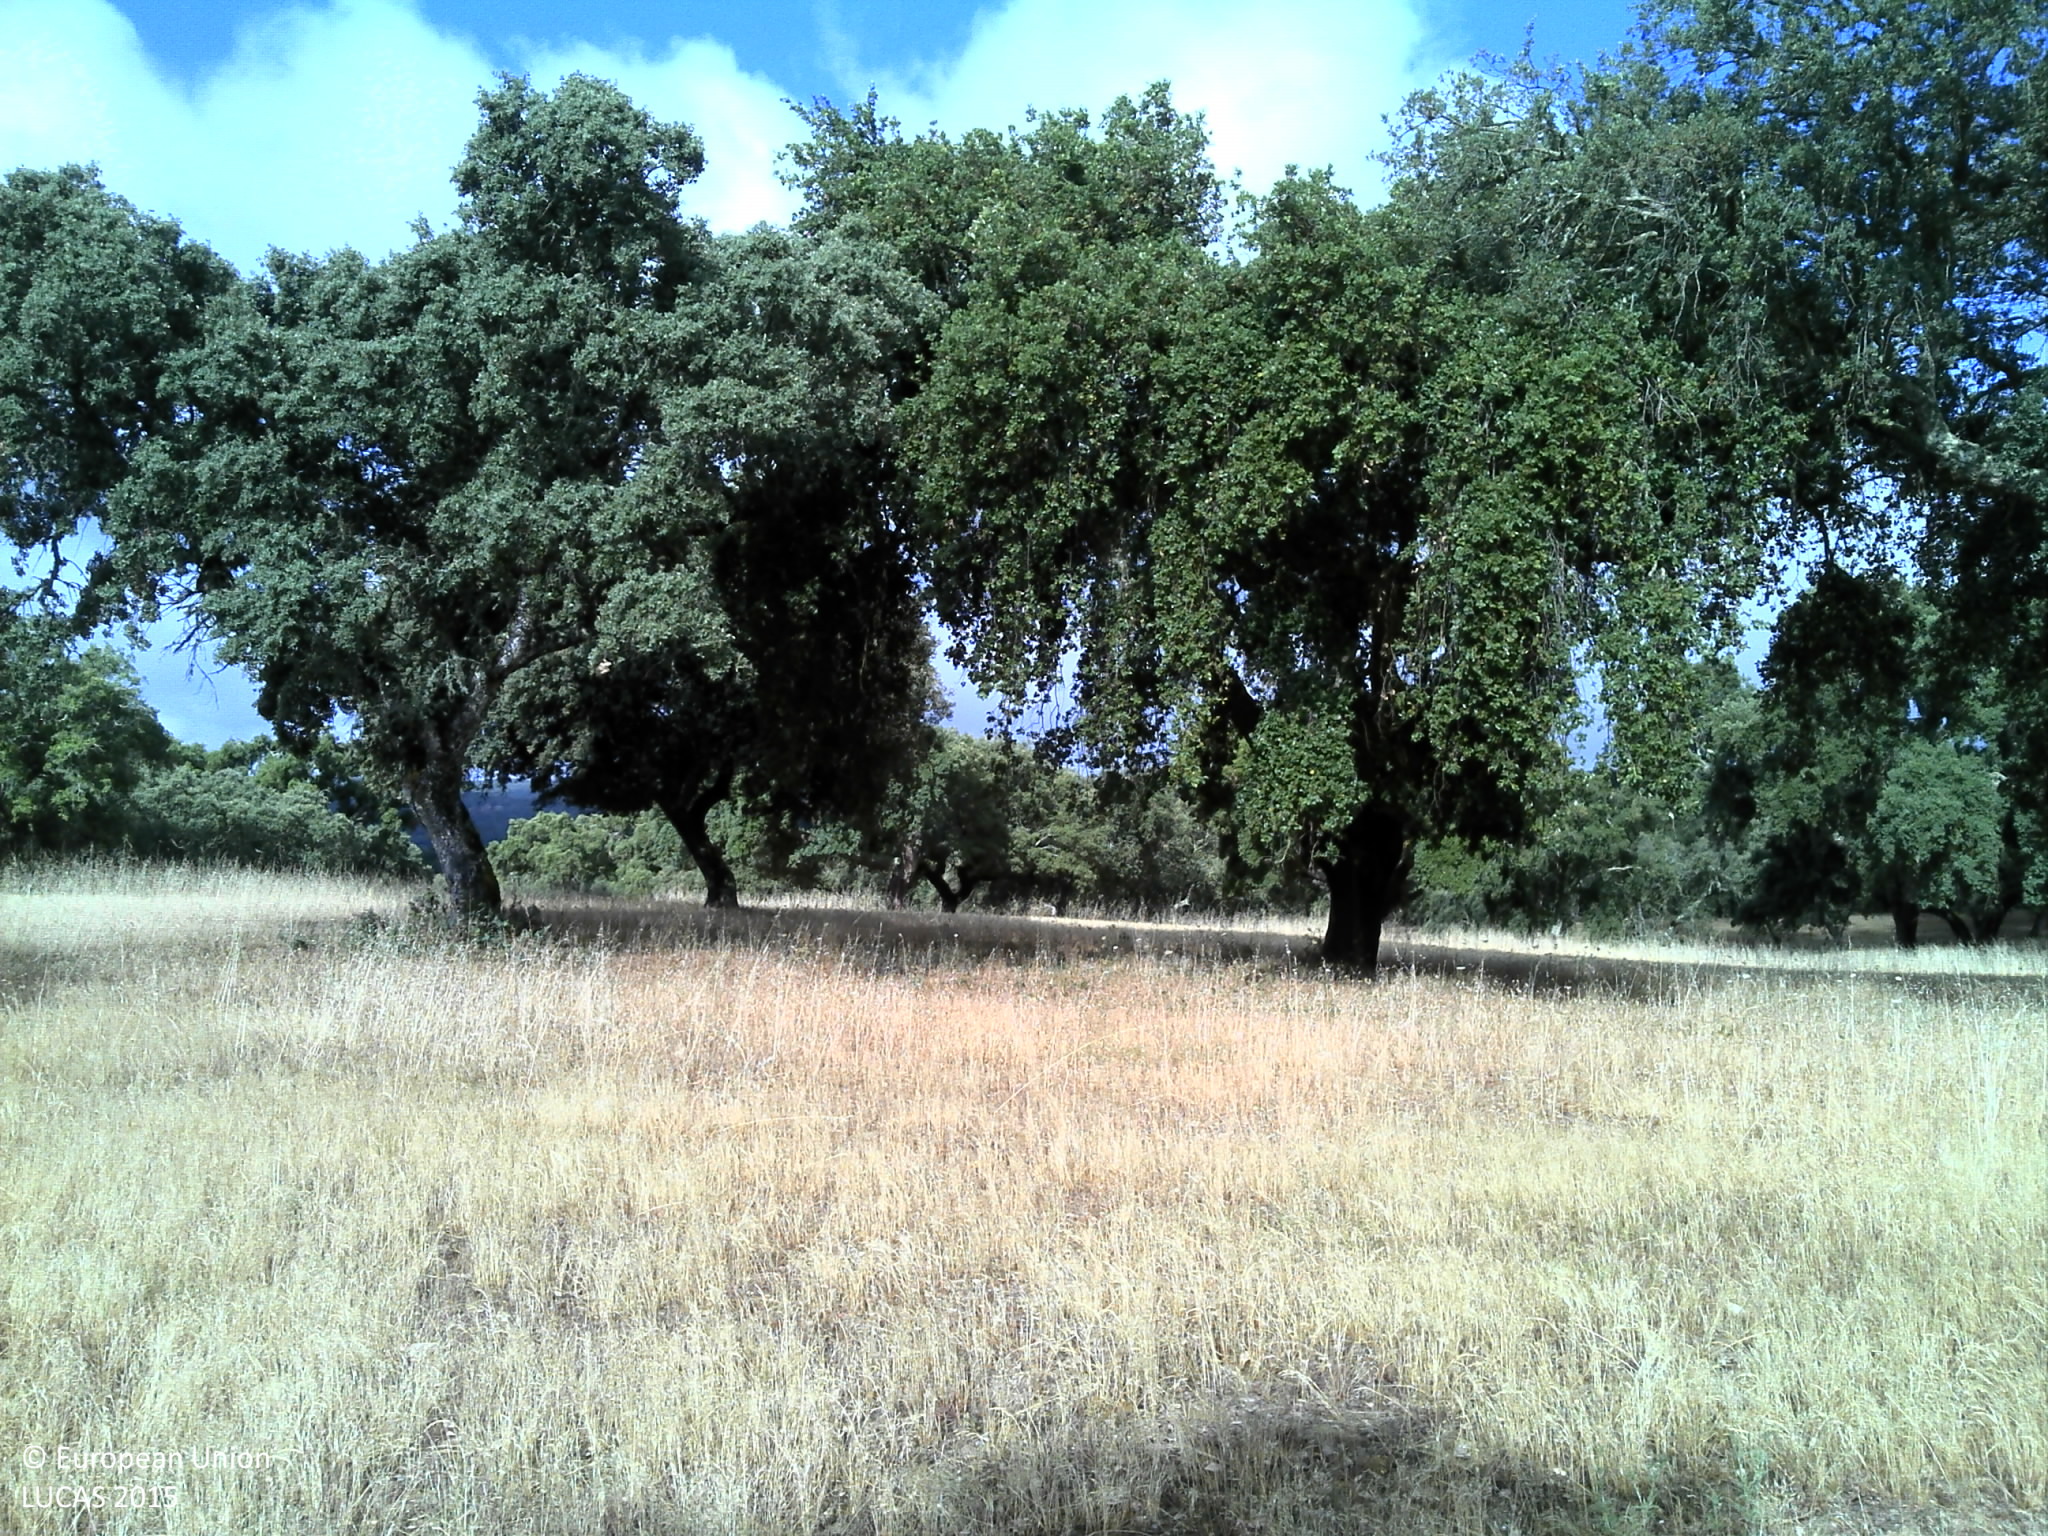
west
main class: Woodland
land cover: Broadleaved woodland
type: broadleaved evergreen forest
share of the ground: 10 - 25 %
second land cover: Spontaneously vegetated surfaces
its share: 25 - 50 %
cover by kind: herbaceous plants 50 %, unconsolidated bare surface 40 %, broadleaved forest trees 10 %
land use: Forestry
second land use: Agriculture (excluding fallow land and kitchen gardens)
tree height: > 5 m
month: June
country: PT
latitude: 38.5811
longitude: -8.0307
